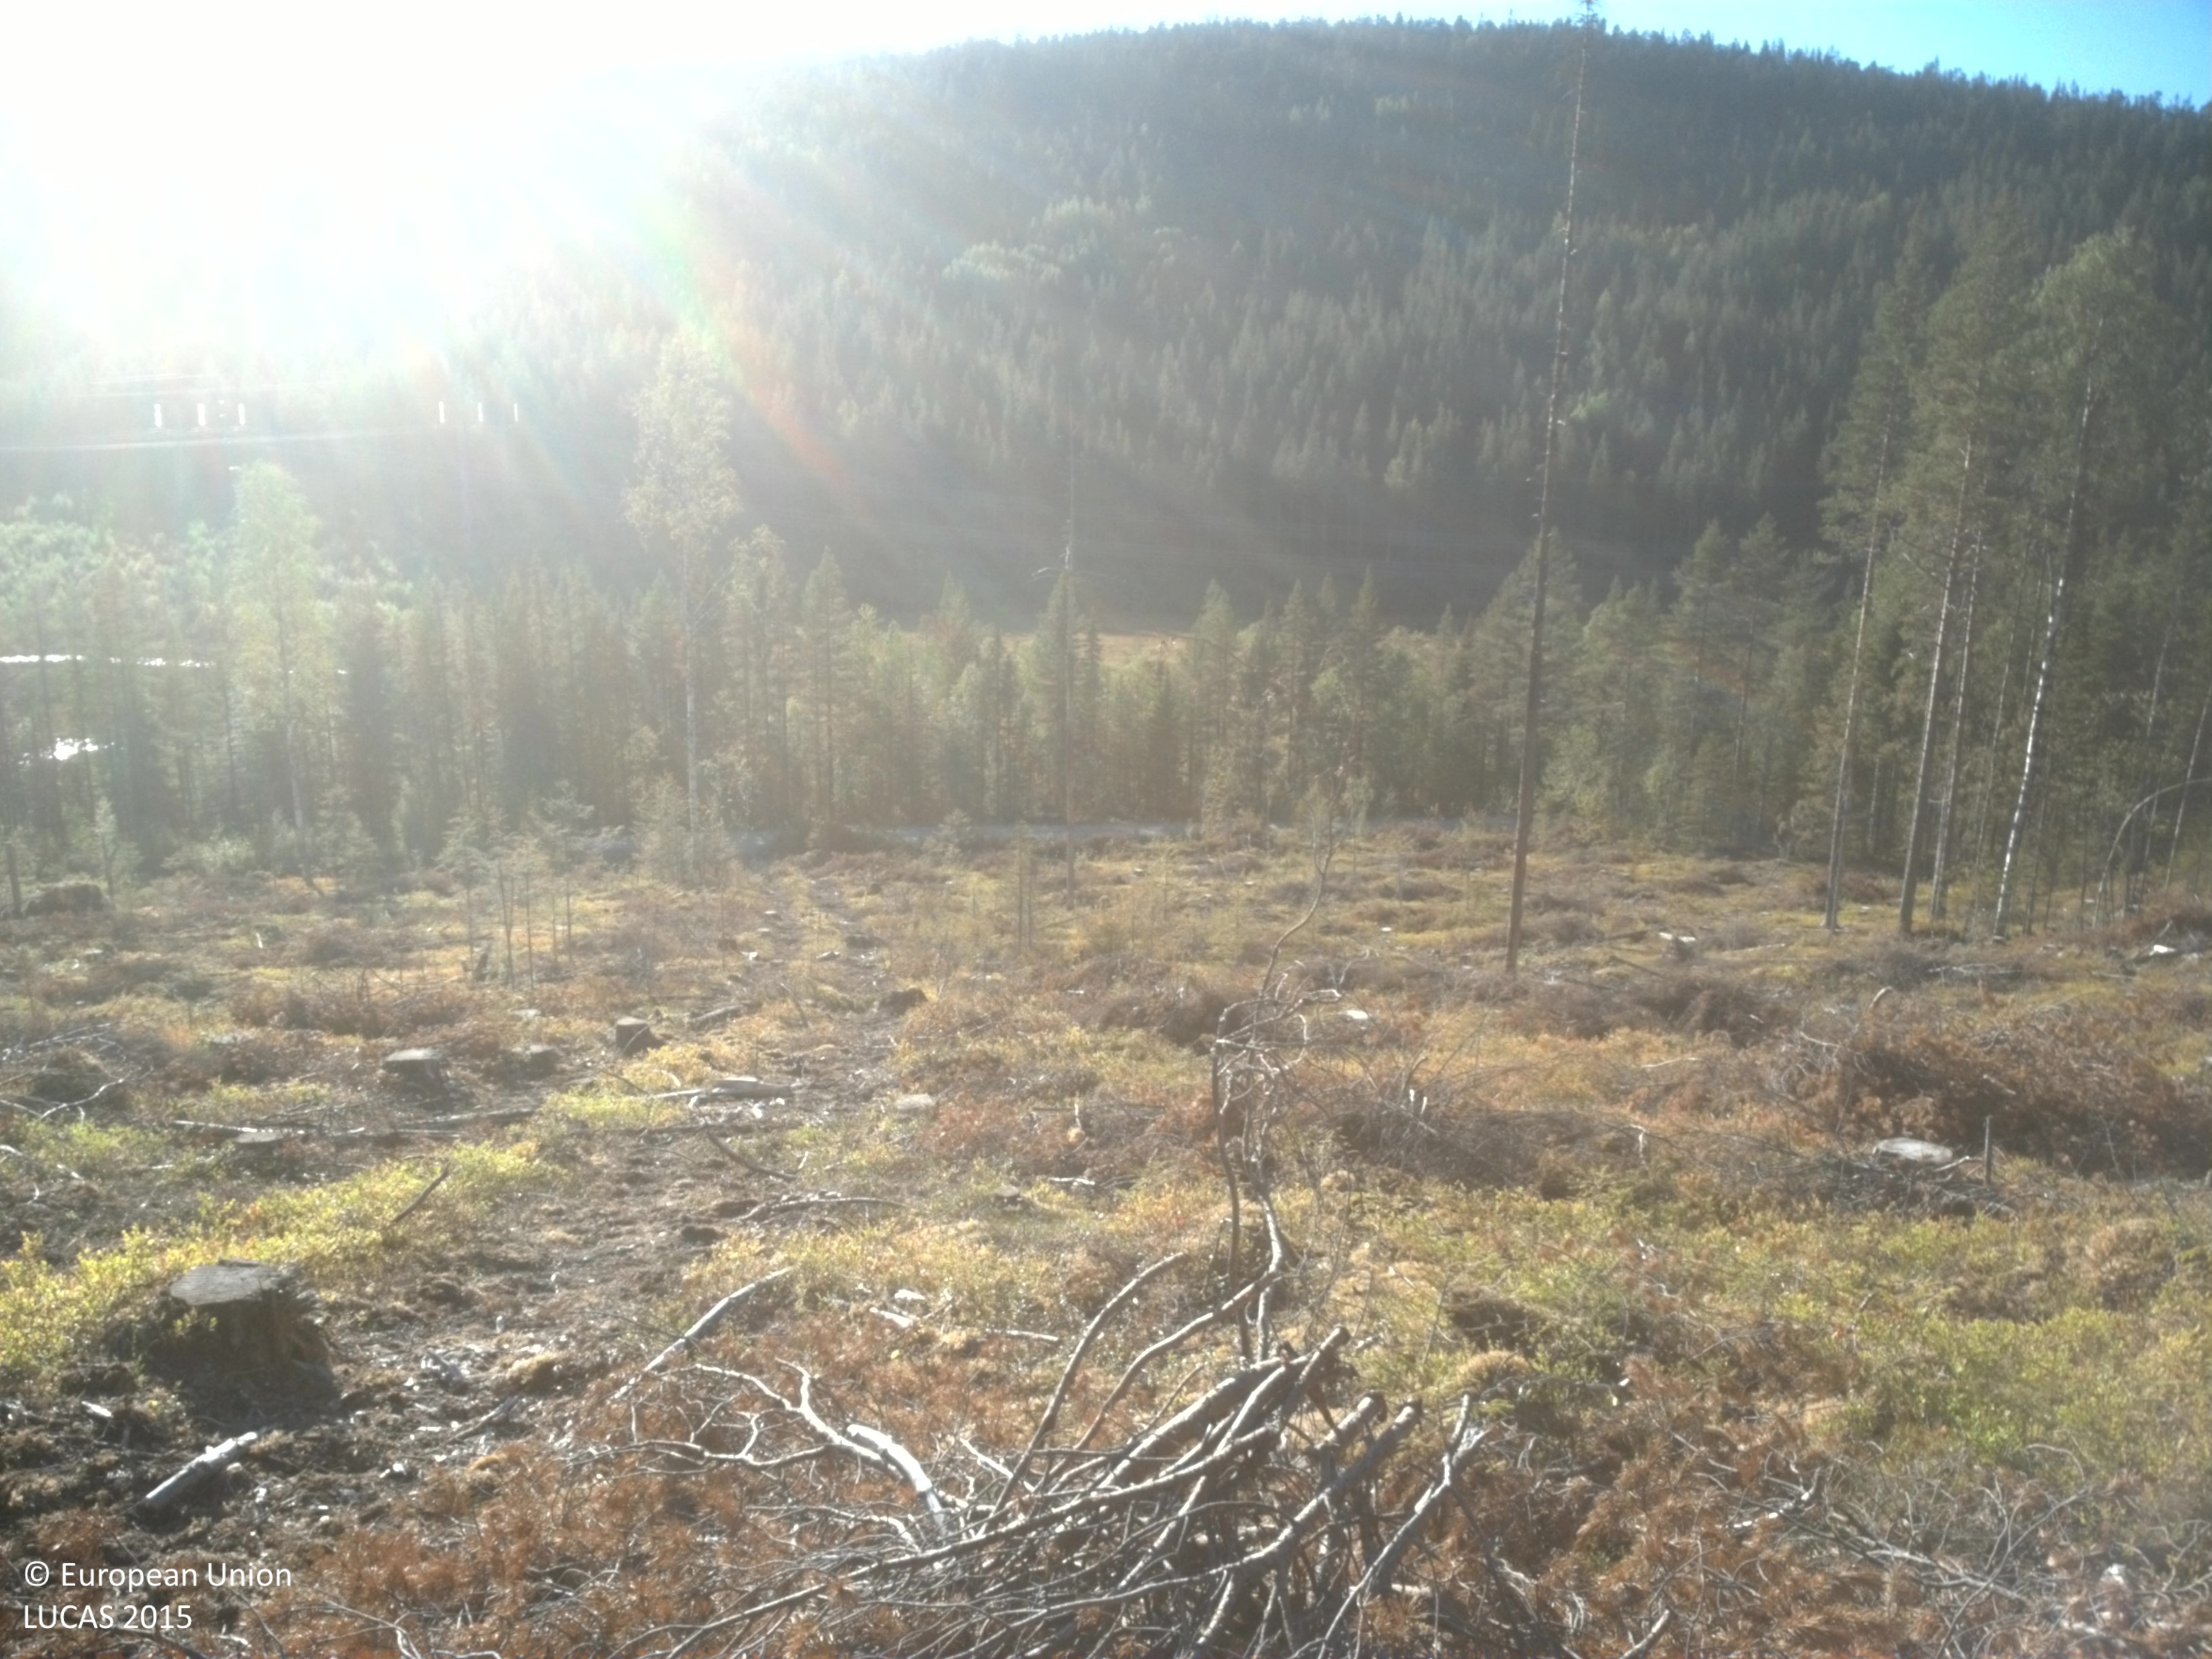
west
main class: Shrubland
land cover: Shrubland with sparse tree cover
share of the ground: > 75 %
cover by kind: shrubs 85 %, lichens and mosses 10 %, coniferous forest trees 5 %
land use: Forestry
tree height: > 5 m
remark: Clear cut
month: August
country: SE
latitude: 64.6275
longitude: 19.1092
